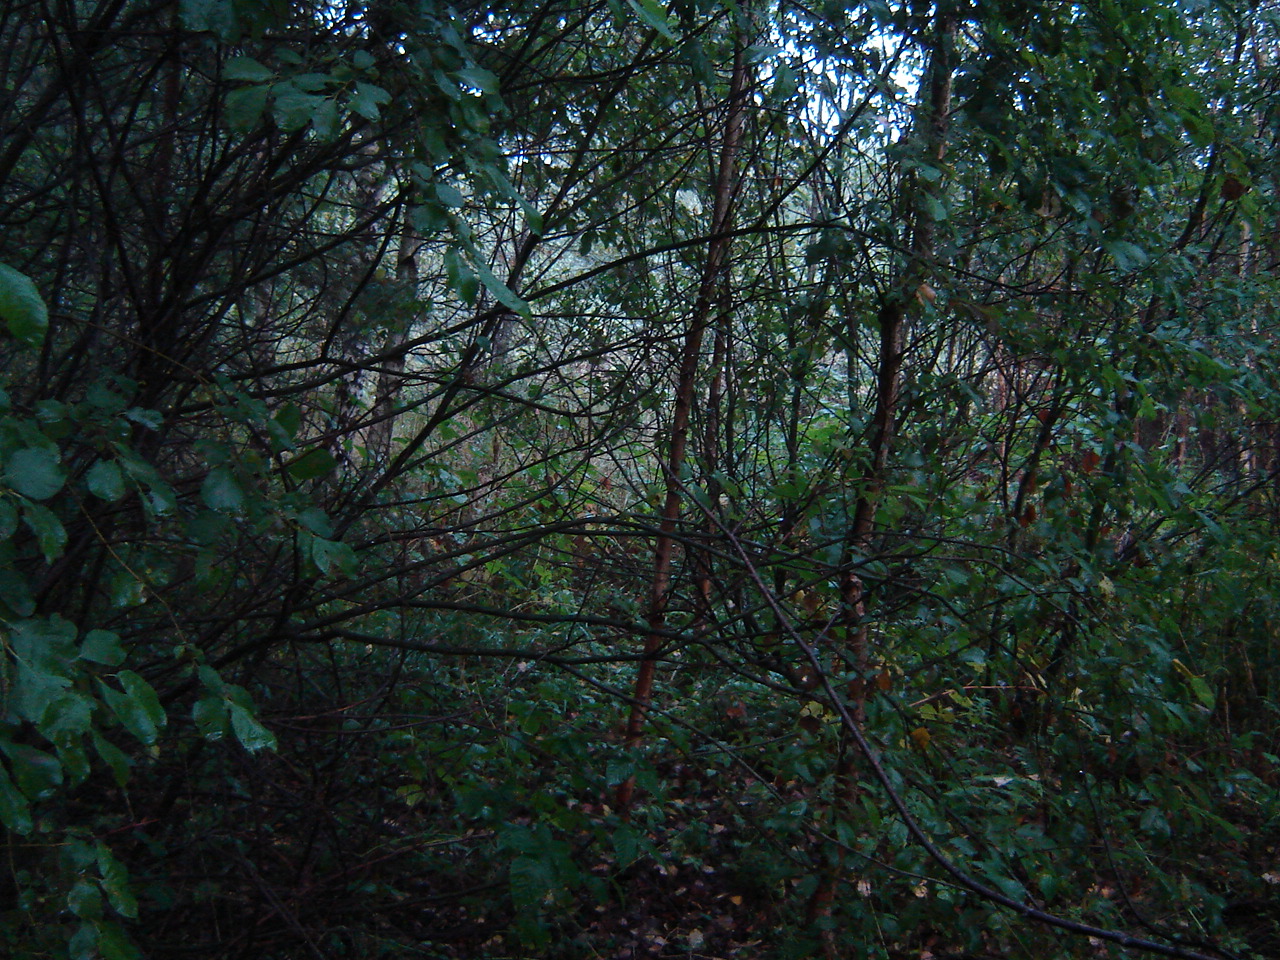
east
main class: Woodland
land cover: Broadleaved woodland
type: mire and swamp forests
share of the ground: > 75 %
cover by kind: broadleaved forest trees 95 %, coniferous forest trees 5 %
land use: Forestry
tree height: > 5 m
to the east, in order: Broadleaved woodland; Inland marshes; Broadleaved woodland; Inland marshes; Broadleaved woodland; Spontaneously vegetated surfaces
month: September
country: LT
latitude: 54.9839
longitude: 25.3264
